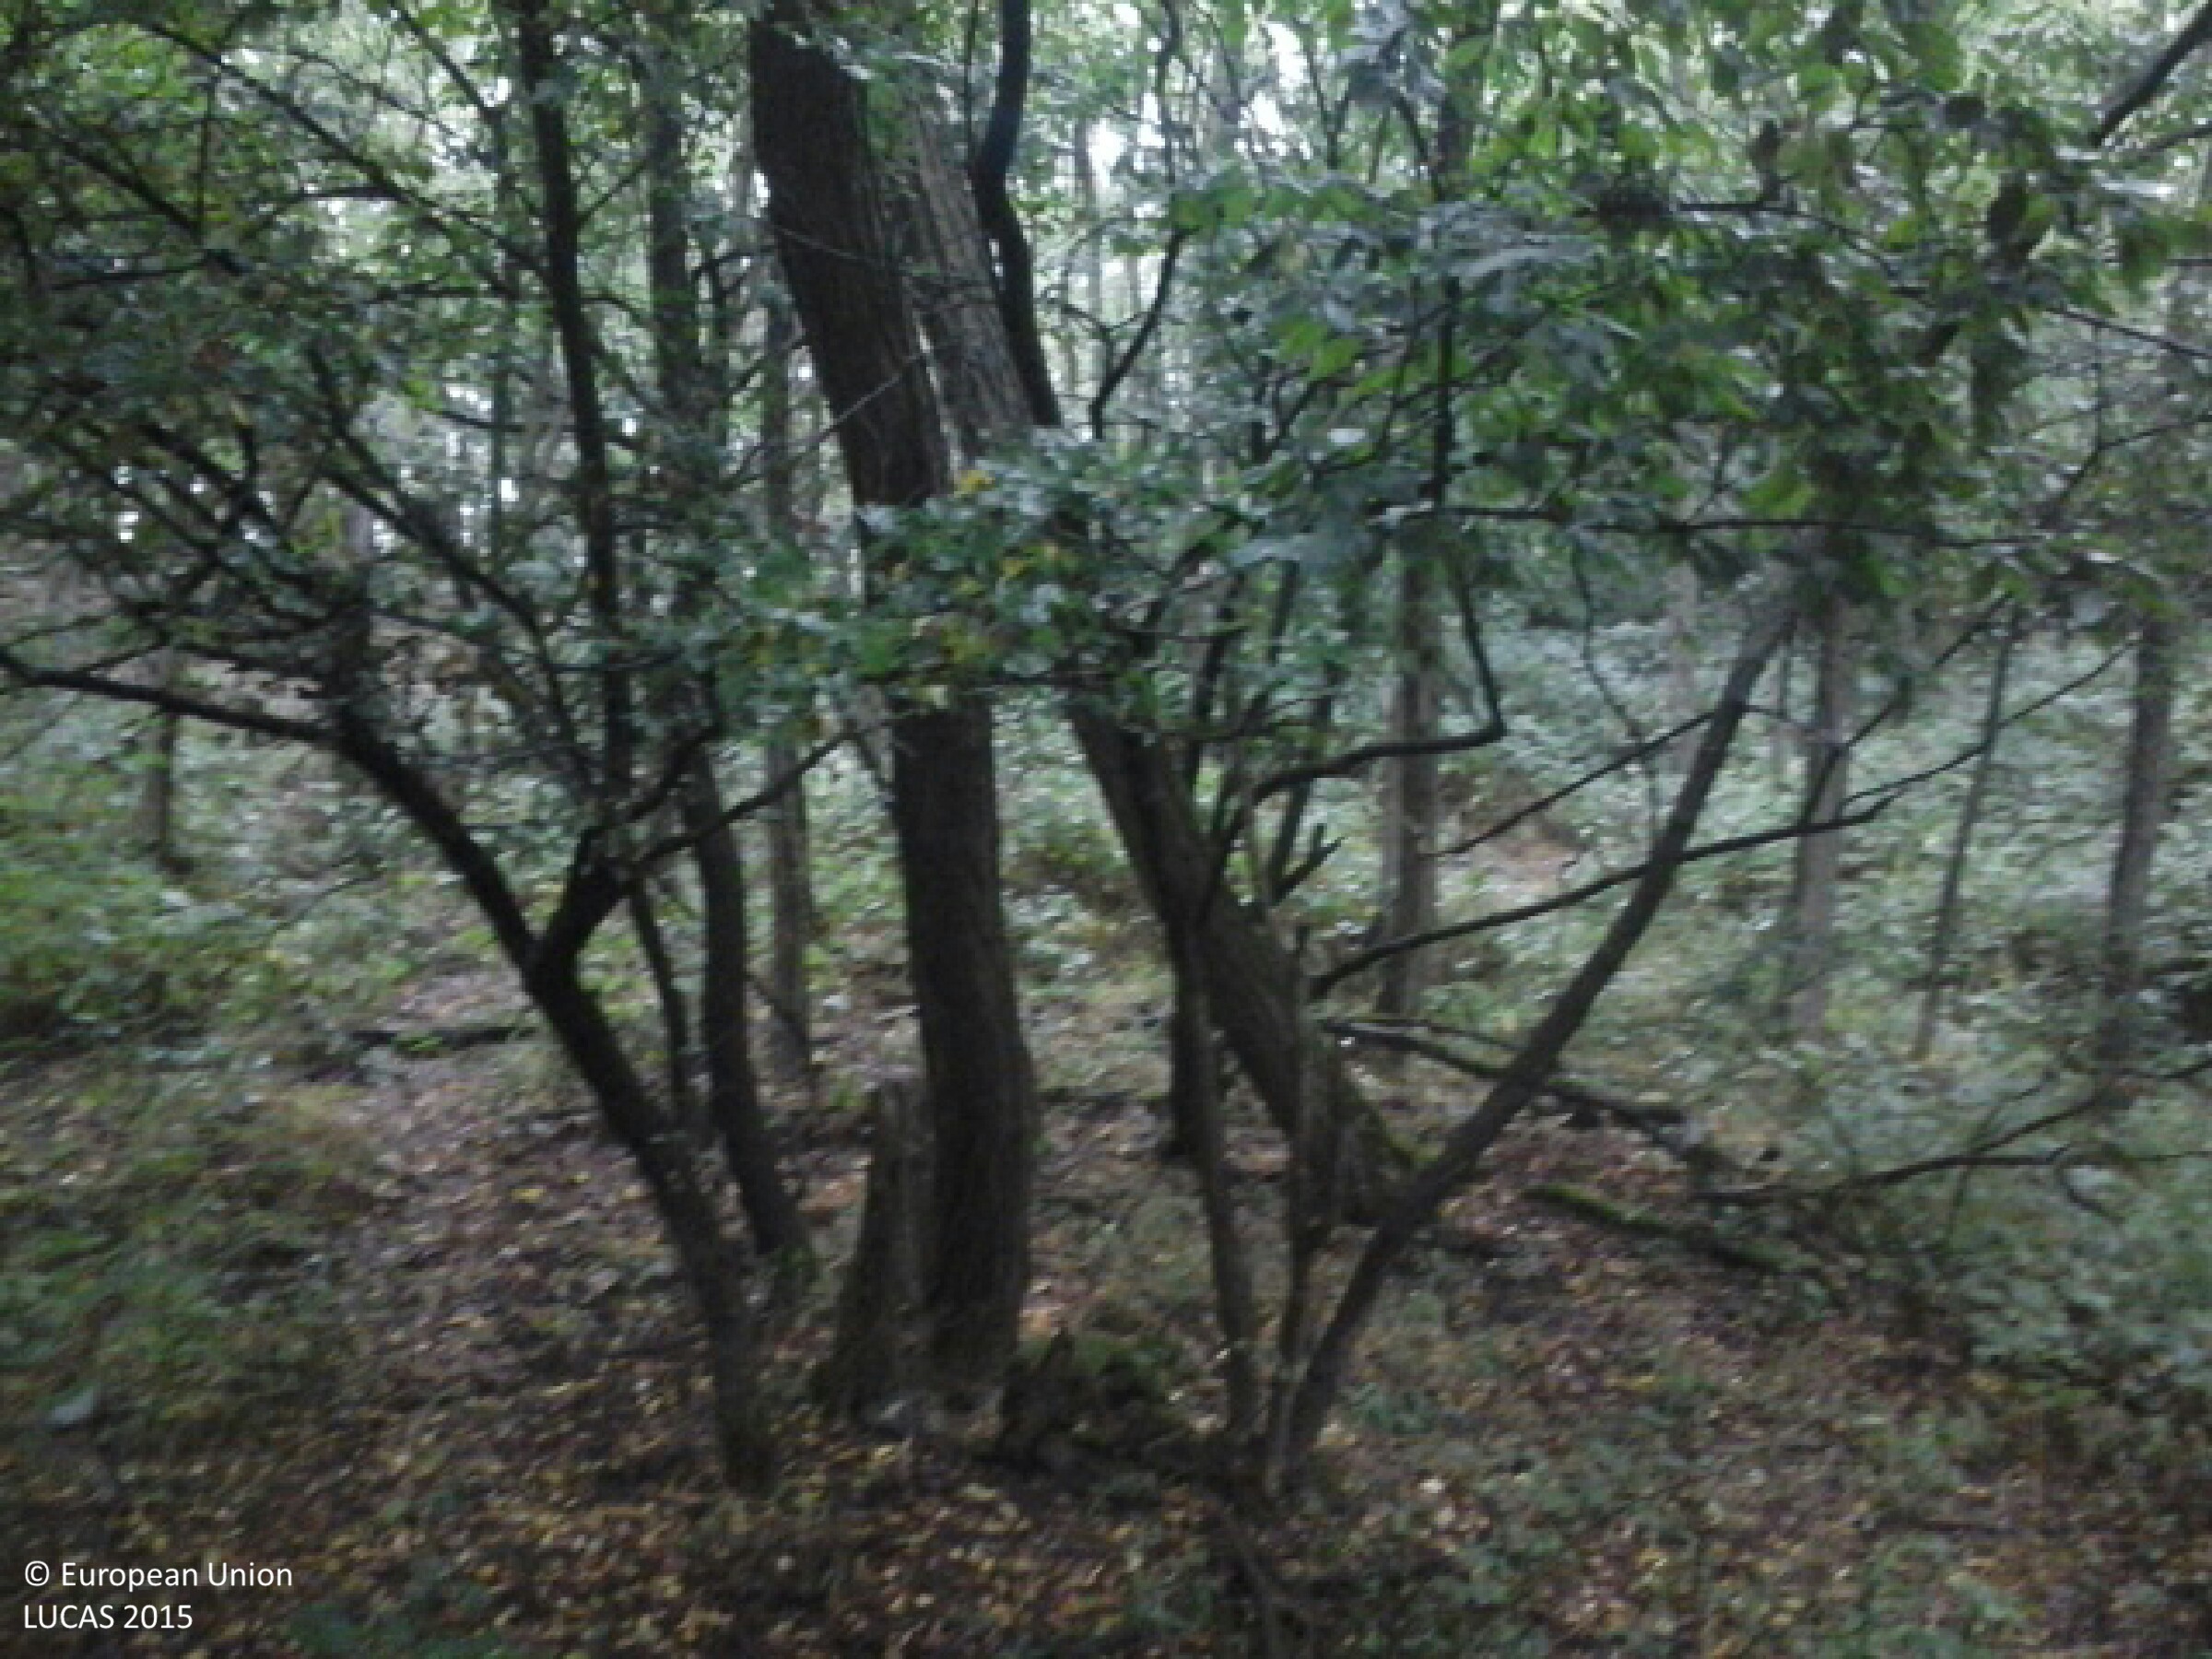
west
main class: Woodland
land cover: Broadleaved woodland
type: mesophytic deciduous forest
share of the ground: > 75 %
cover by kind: broadleaved forest trees 95 %, shrubs 5 %
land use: Forestry
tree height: > 5 m
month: July
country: HU
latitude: 48.5031
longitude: 21.5658
